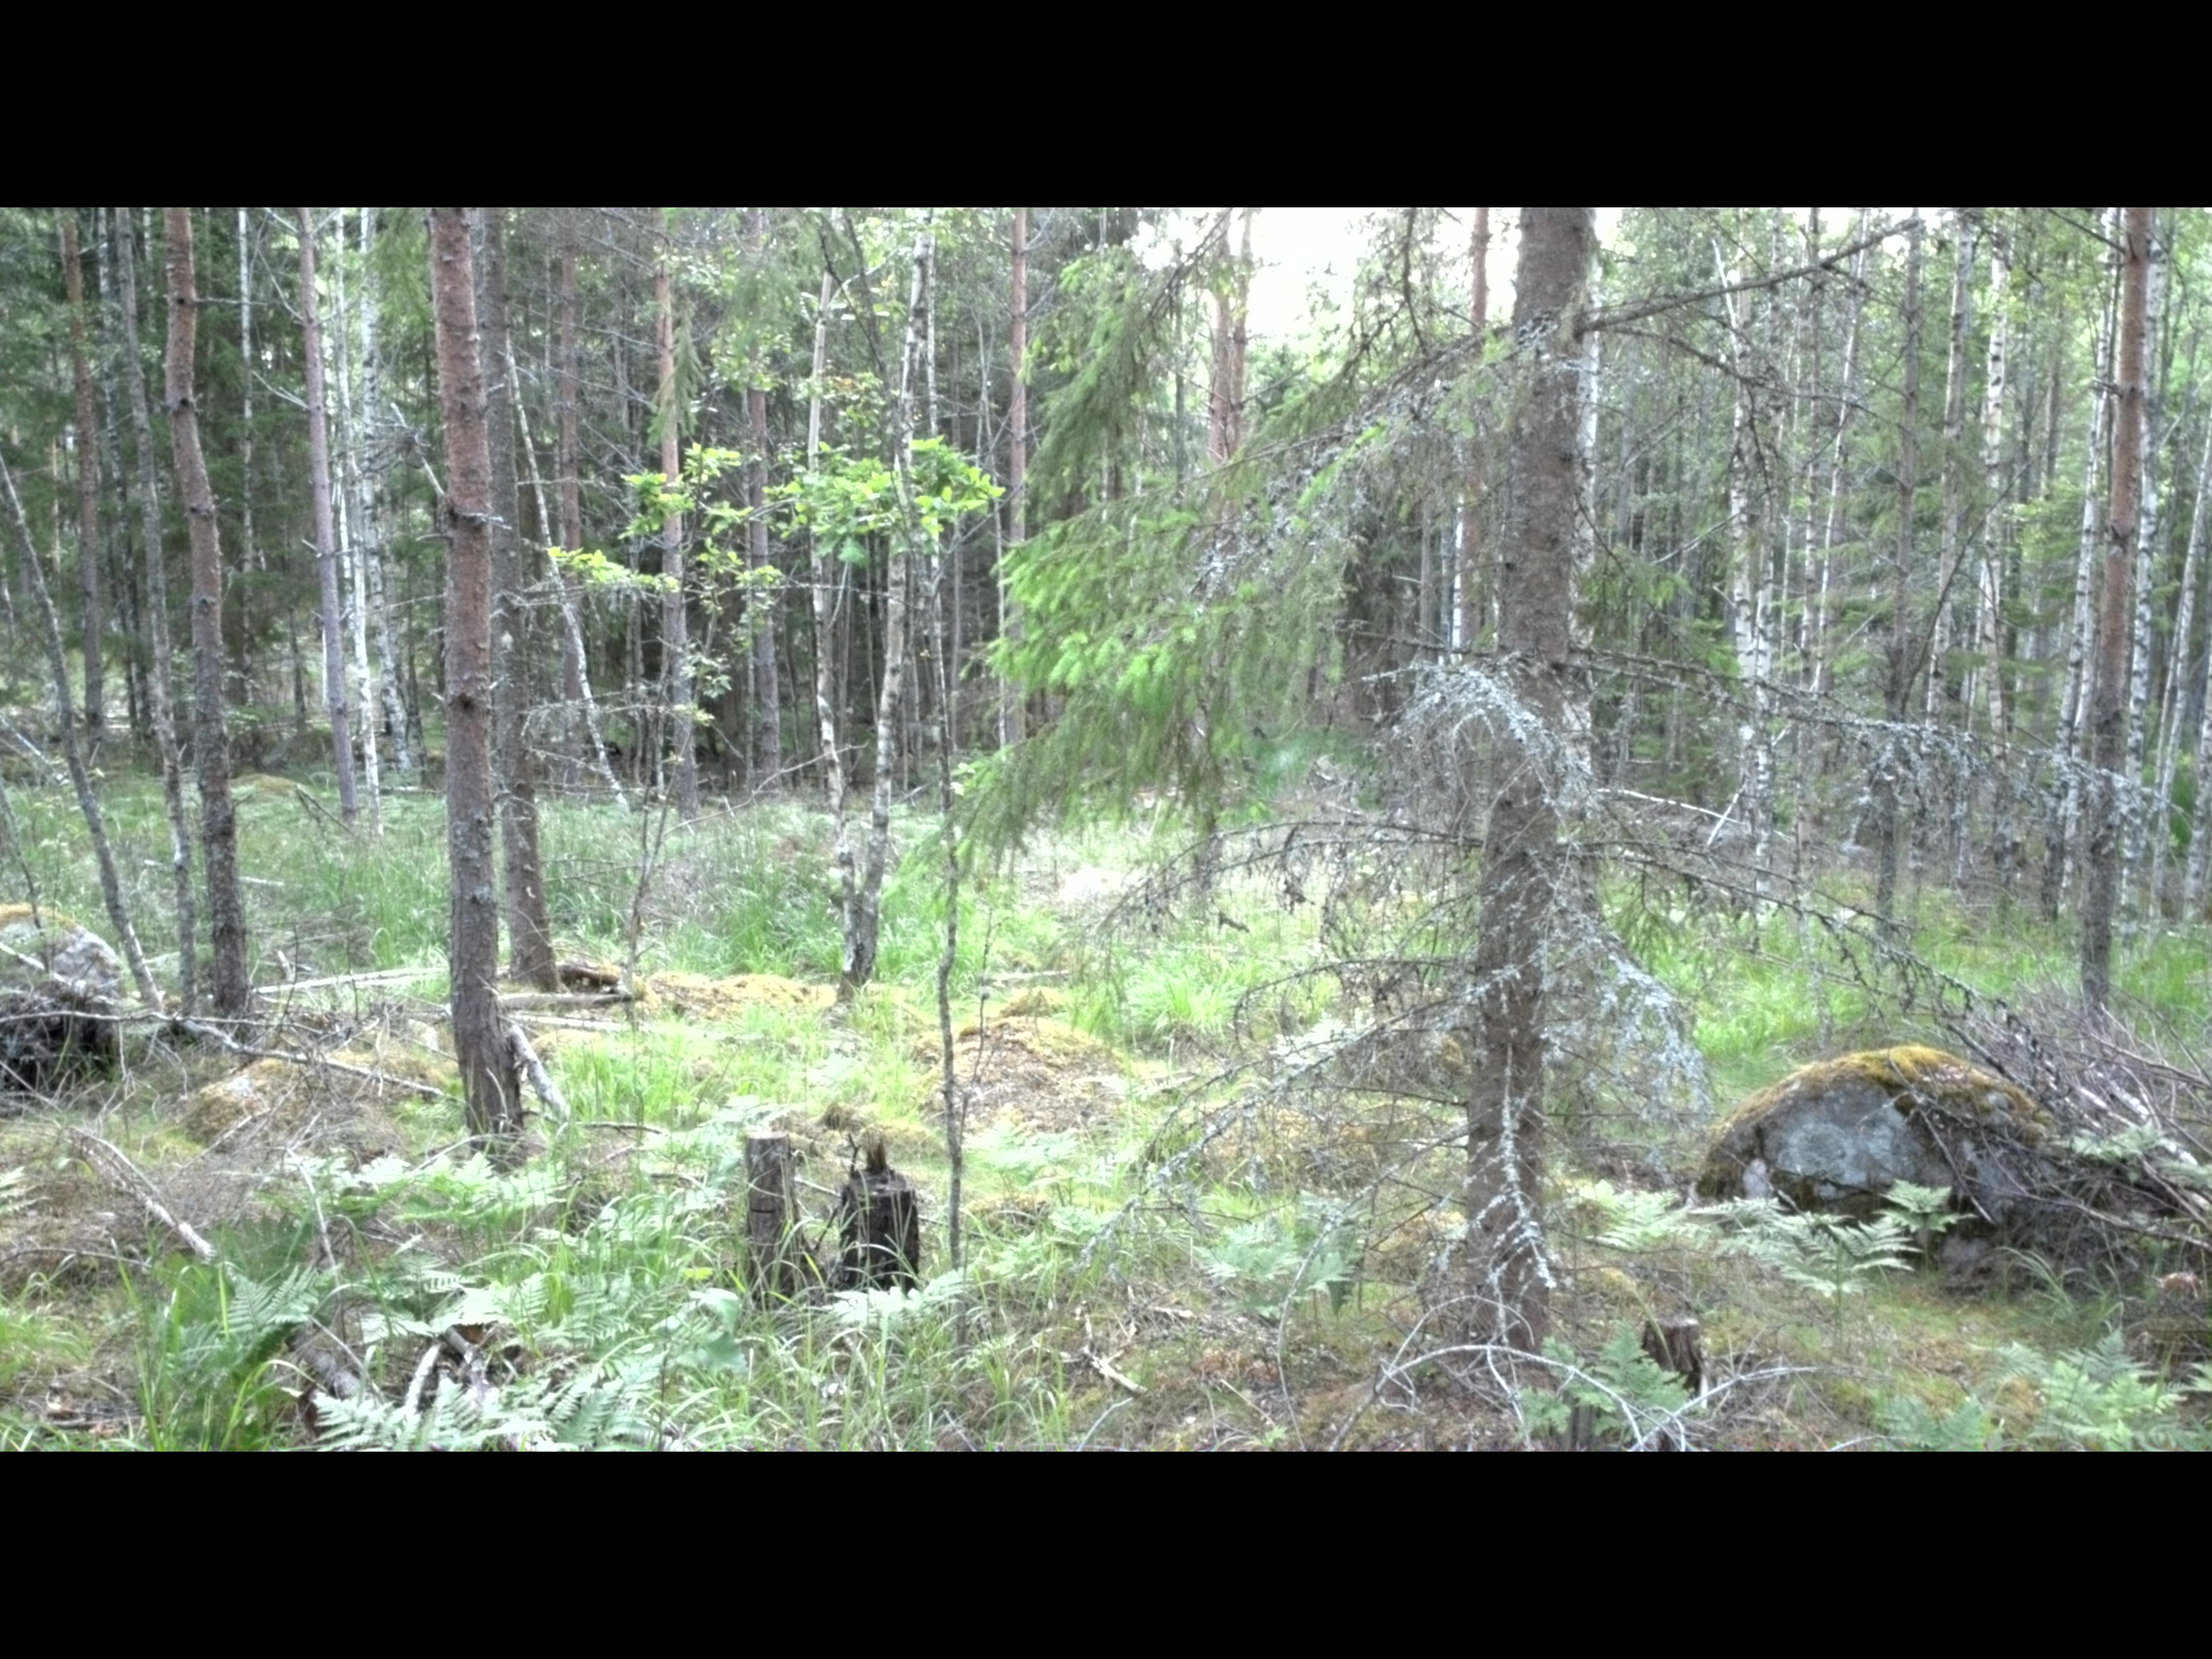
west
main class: Woodland
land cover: Pine dominated mixed woodland
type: boreal forest
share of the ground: 50 - 75 %
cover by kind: coniferous forest trees 45 %, broadleaved forest trees 20 %, herbaceous plants 15 %, shrubs 10 %, lichens and mosses 10 %
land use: Forestry
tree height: > 5 m
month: June
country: SE
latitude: 58.2562
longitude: 16.2162
